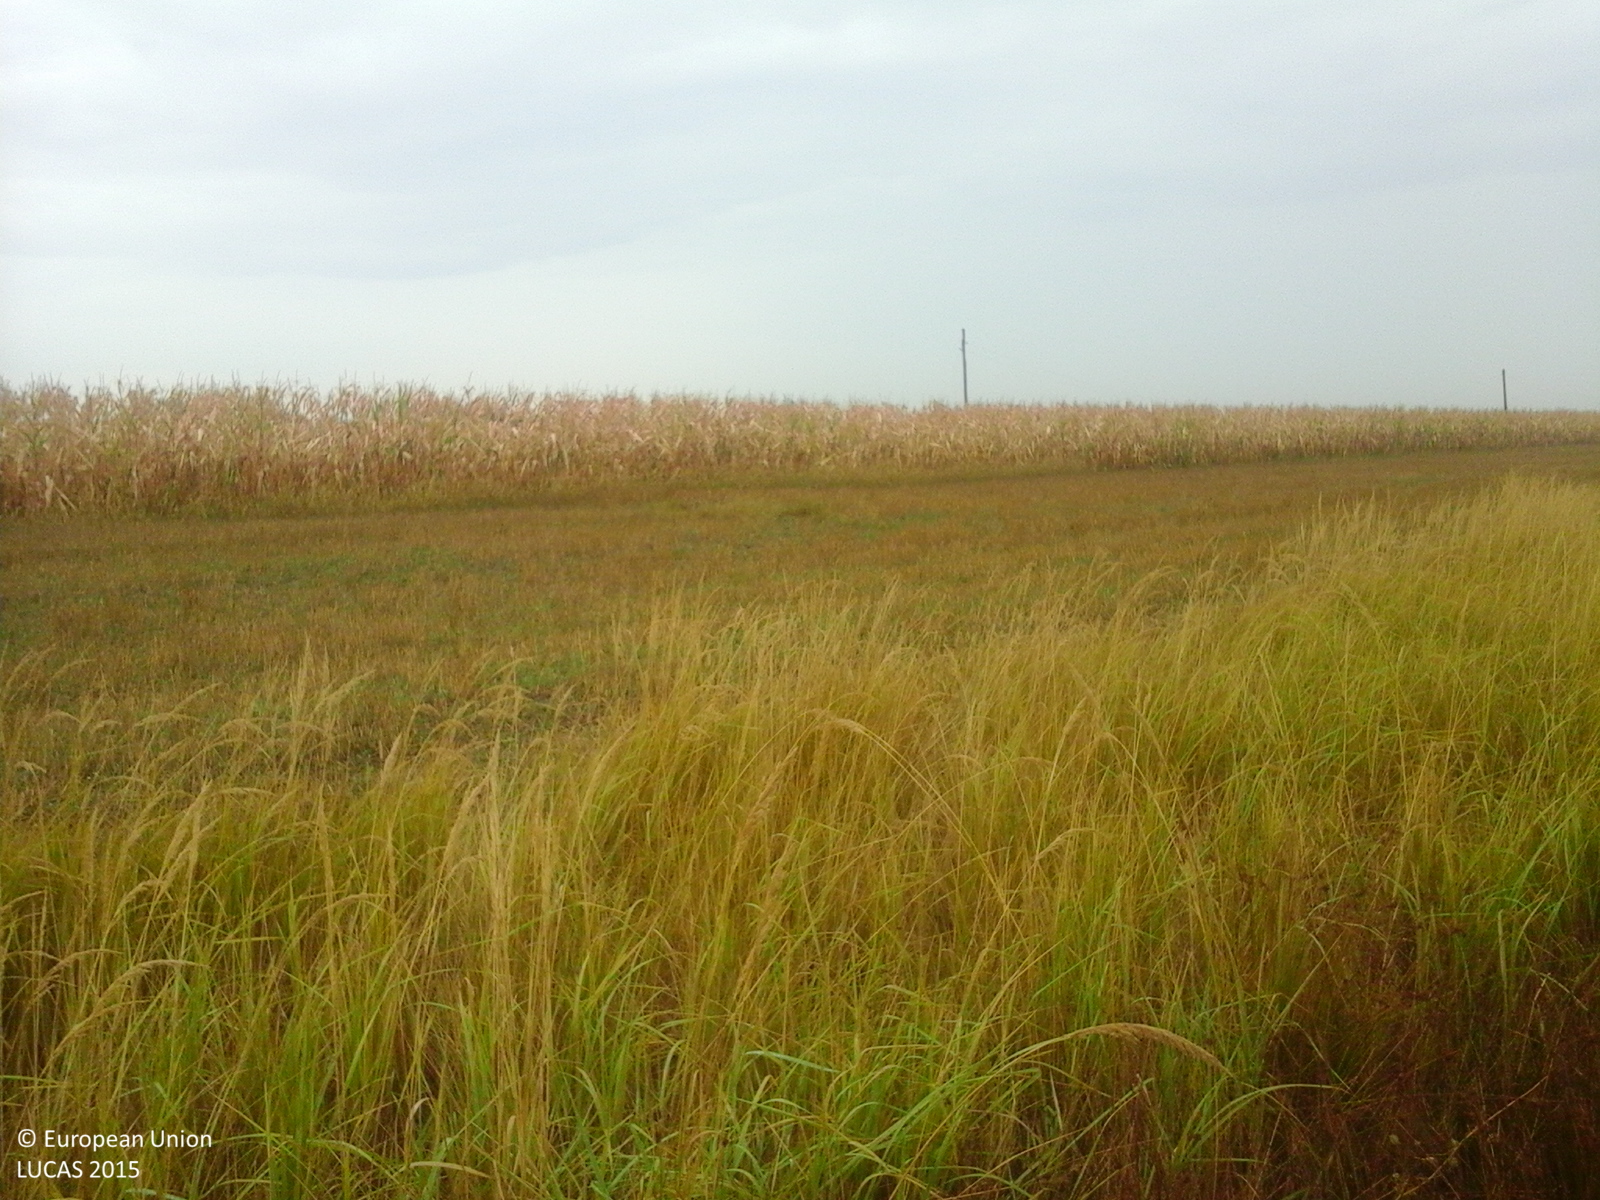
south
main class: Grassland
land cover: Spontaneously vegetated surfaces
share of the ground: > 75 %
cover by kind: herbaceous plants 100 %
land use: Fallow land
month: September
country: RO
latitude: 47.5737
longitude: 22.5679
